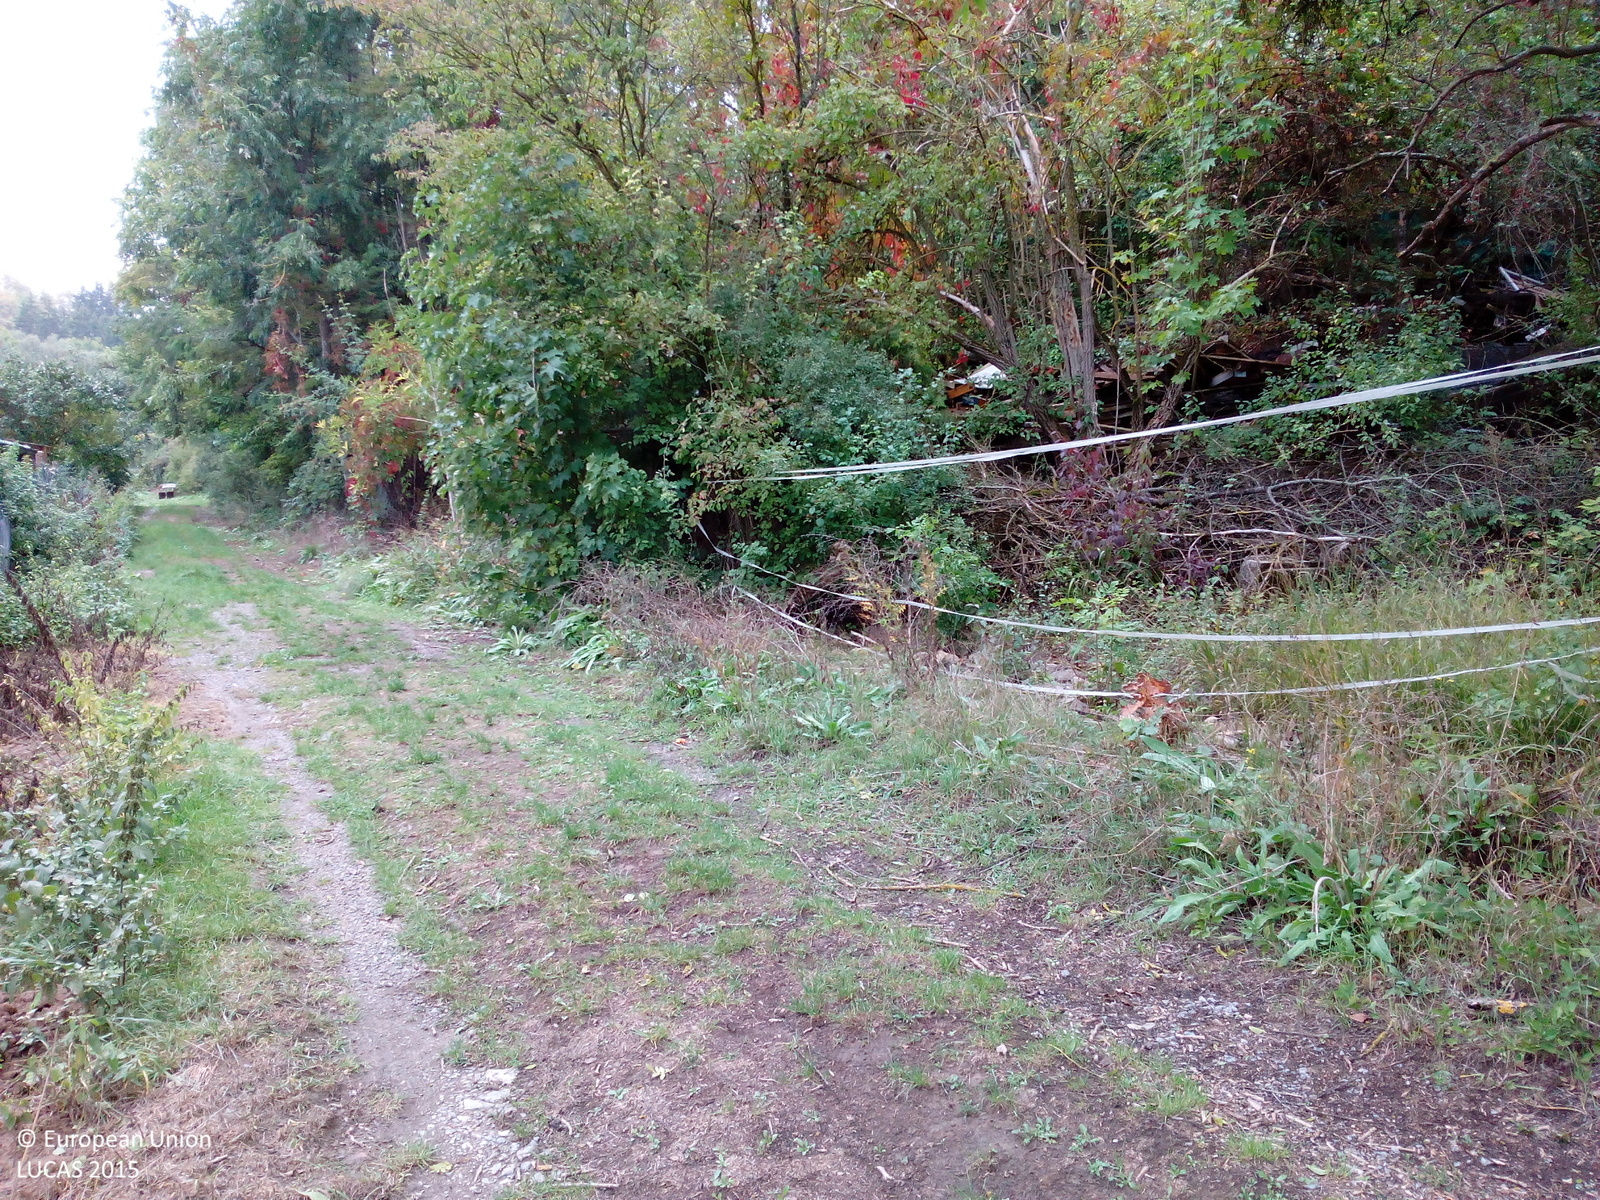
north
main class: Cropland
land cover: Apple fruit
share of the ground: > 75 %
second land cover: Grassland without tree/shrub cover
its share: > 75 %
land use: Kitchen garden
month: September
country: DE
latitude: 49.8425
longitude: 9.9583
